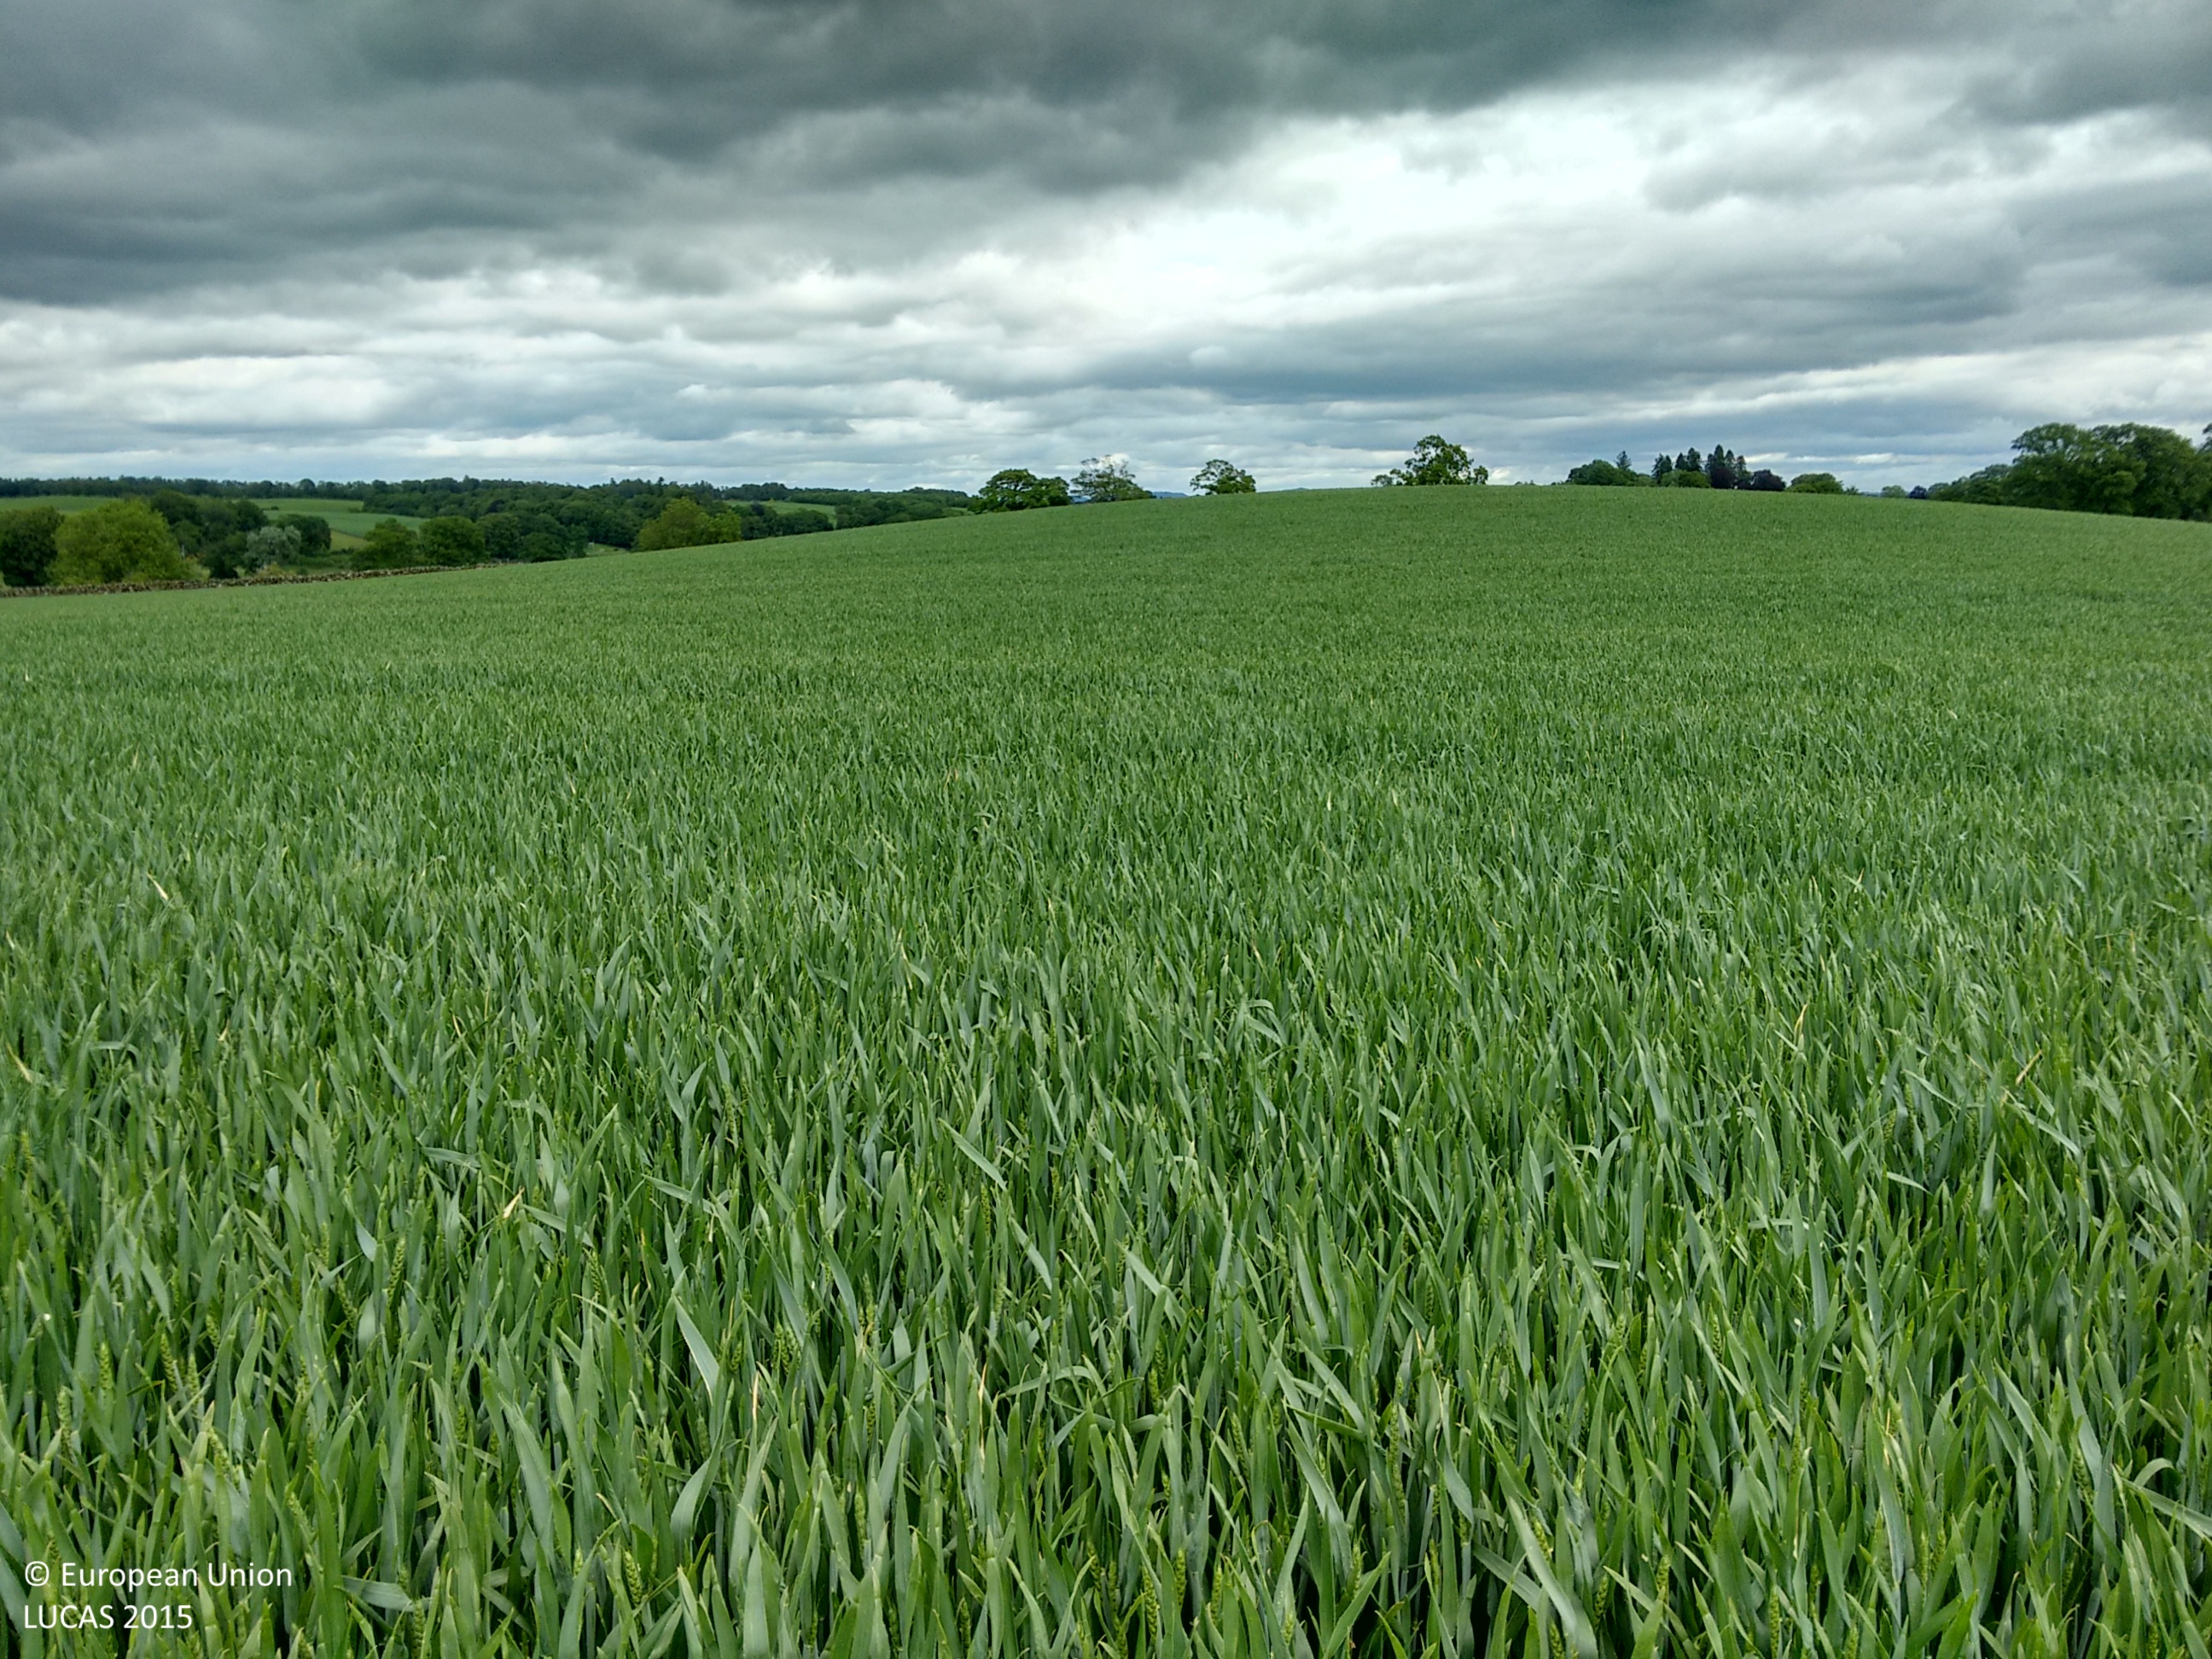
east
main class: Cropland
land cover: Common wheat
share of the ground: > 75 %
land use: Agriculture (excluding fallow land and kitchen gardens)
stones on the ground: 25 - 50 %
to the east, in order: Common wheat; Grass margins; Dry stone walls; Fences; Grass margins; Barley
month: June
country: GB
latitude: 56.5061
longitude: -3.5455
